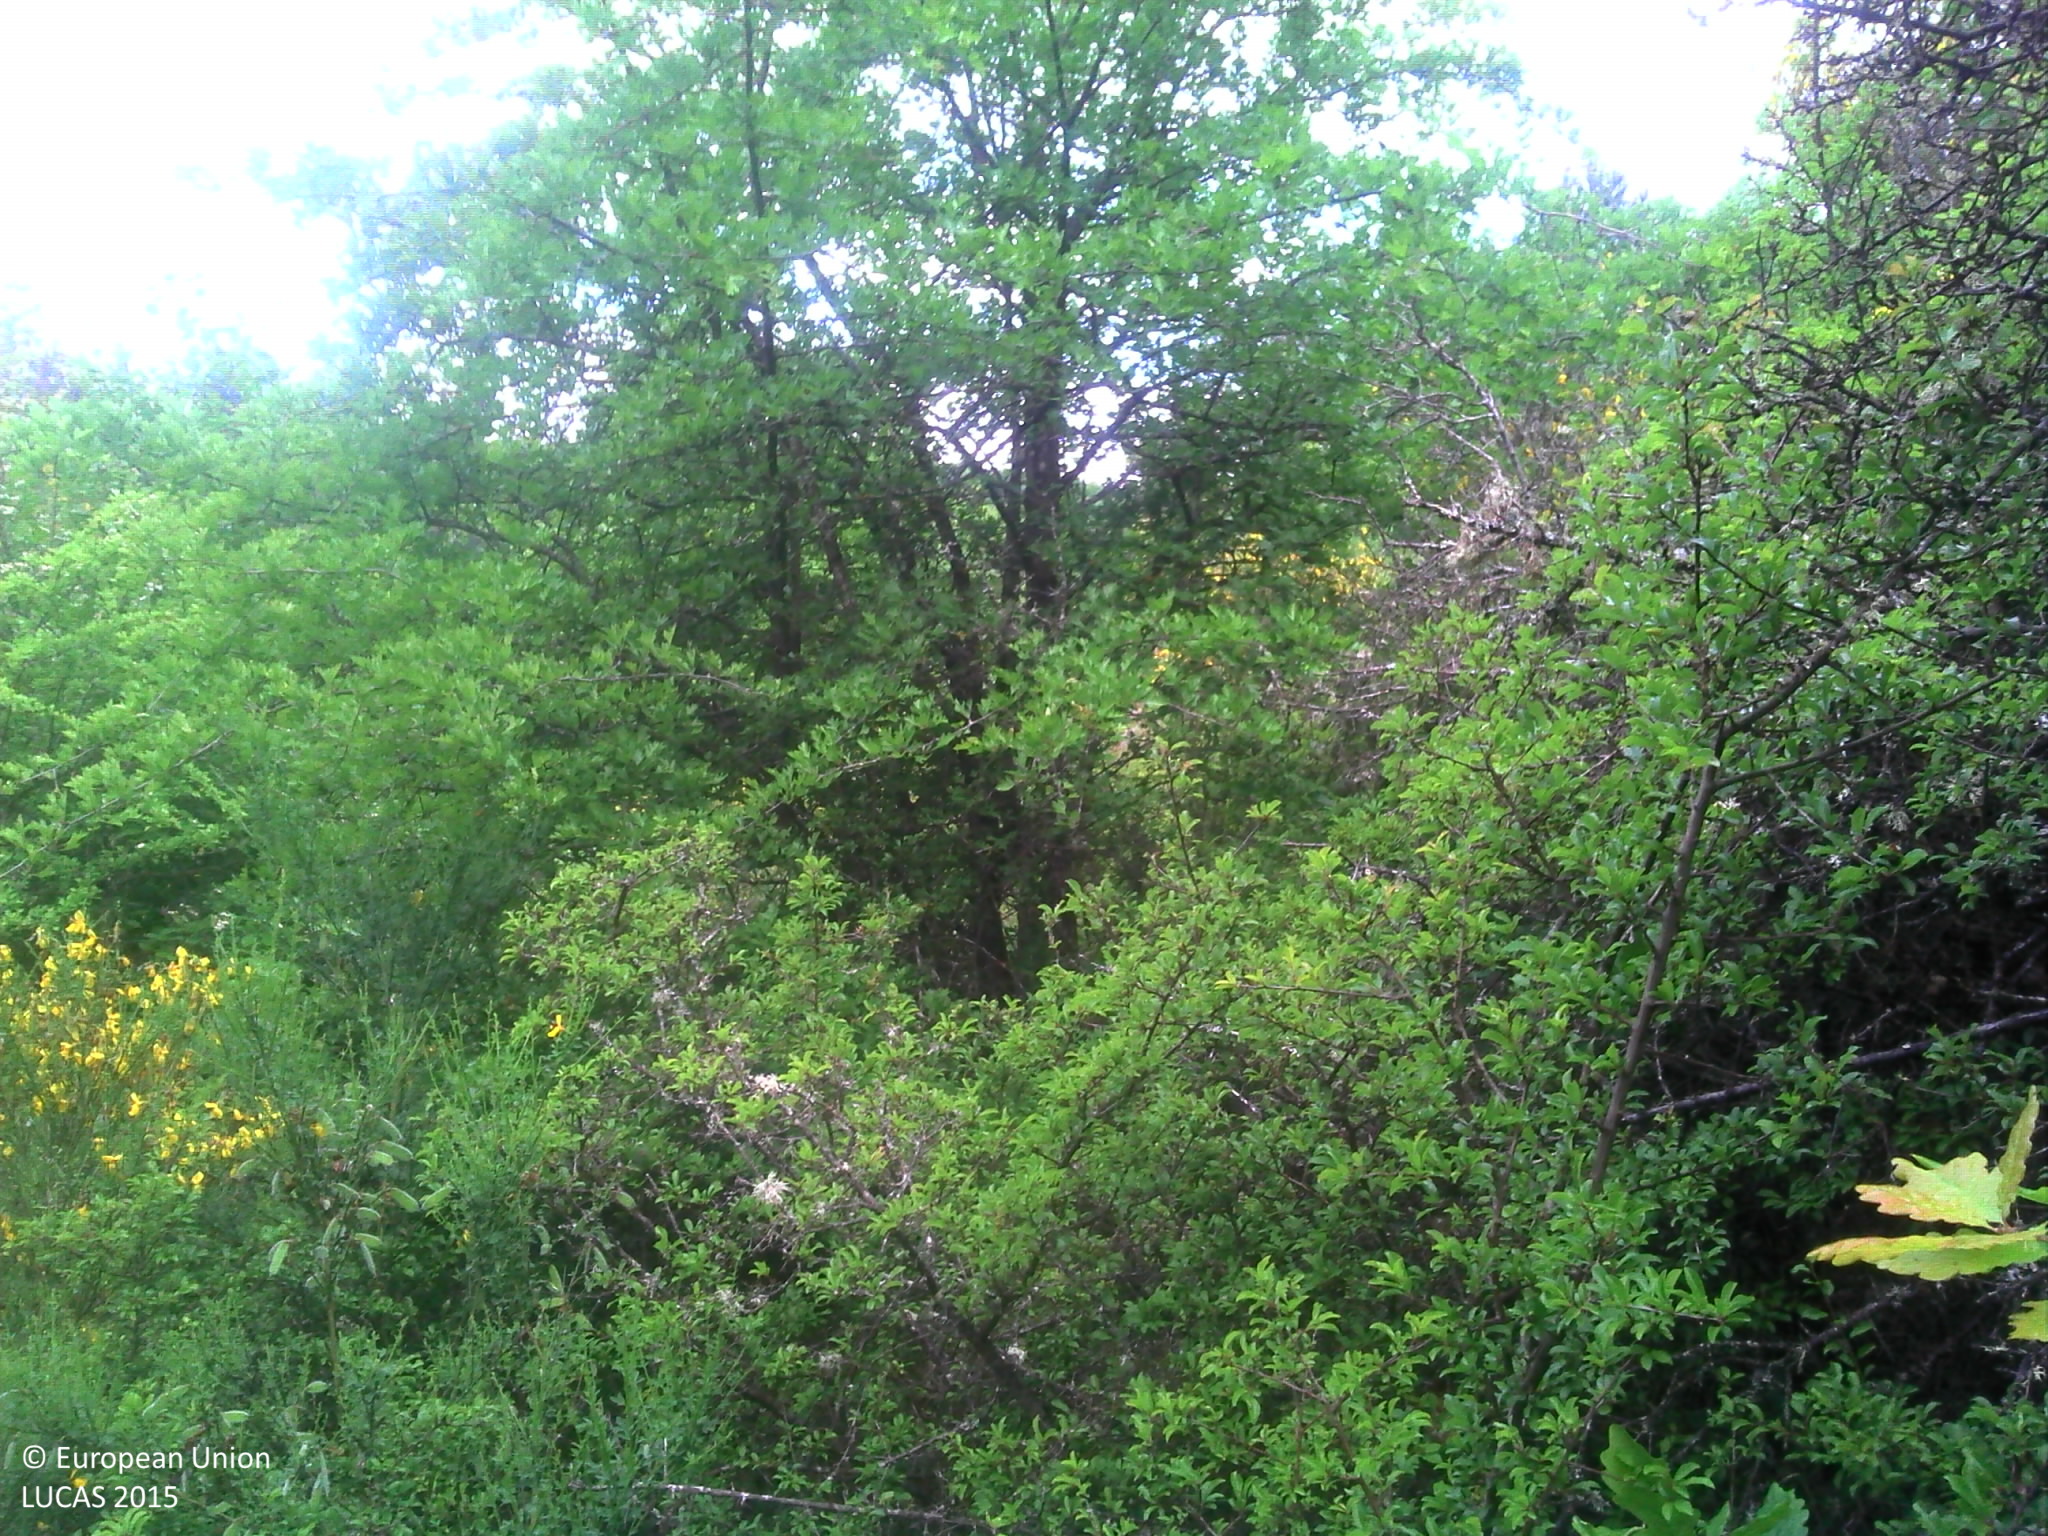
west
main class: Shrubland
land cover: Shrubland with sparse tree cover
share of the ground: > 75 %
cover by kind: shrubs 85 %, herbaceous plants 10 %, broadleaved forest trees 5 %
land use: Semi-natural and natural areas not in use
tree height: > 5 m
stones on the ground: < 10 %
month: June
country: FR
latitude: 45.1583
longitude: 3.1964
